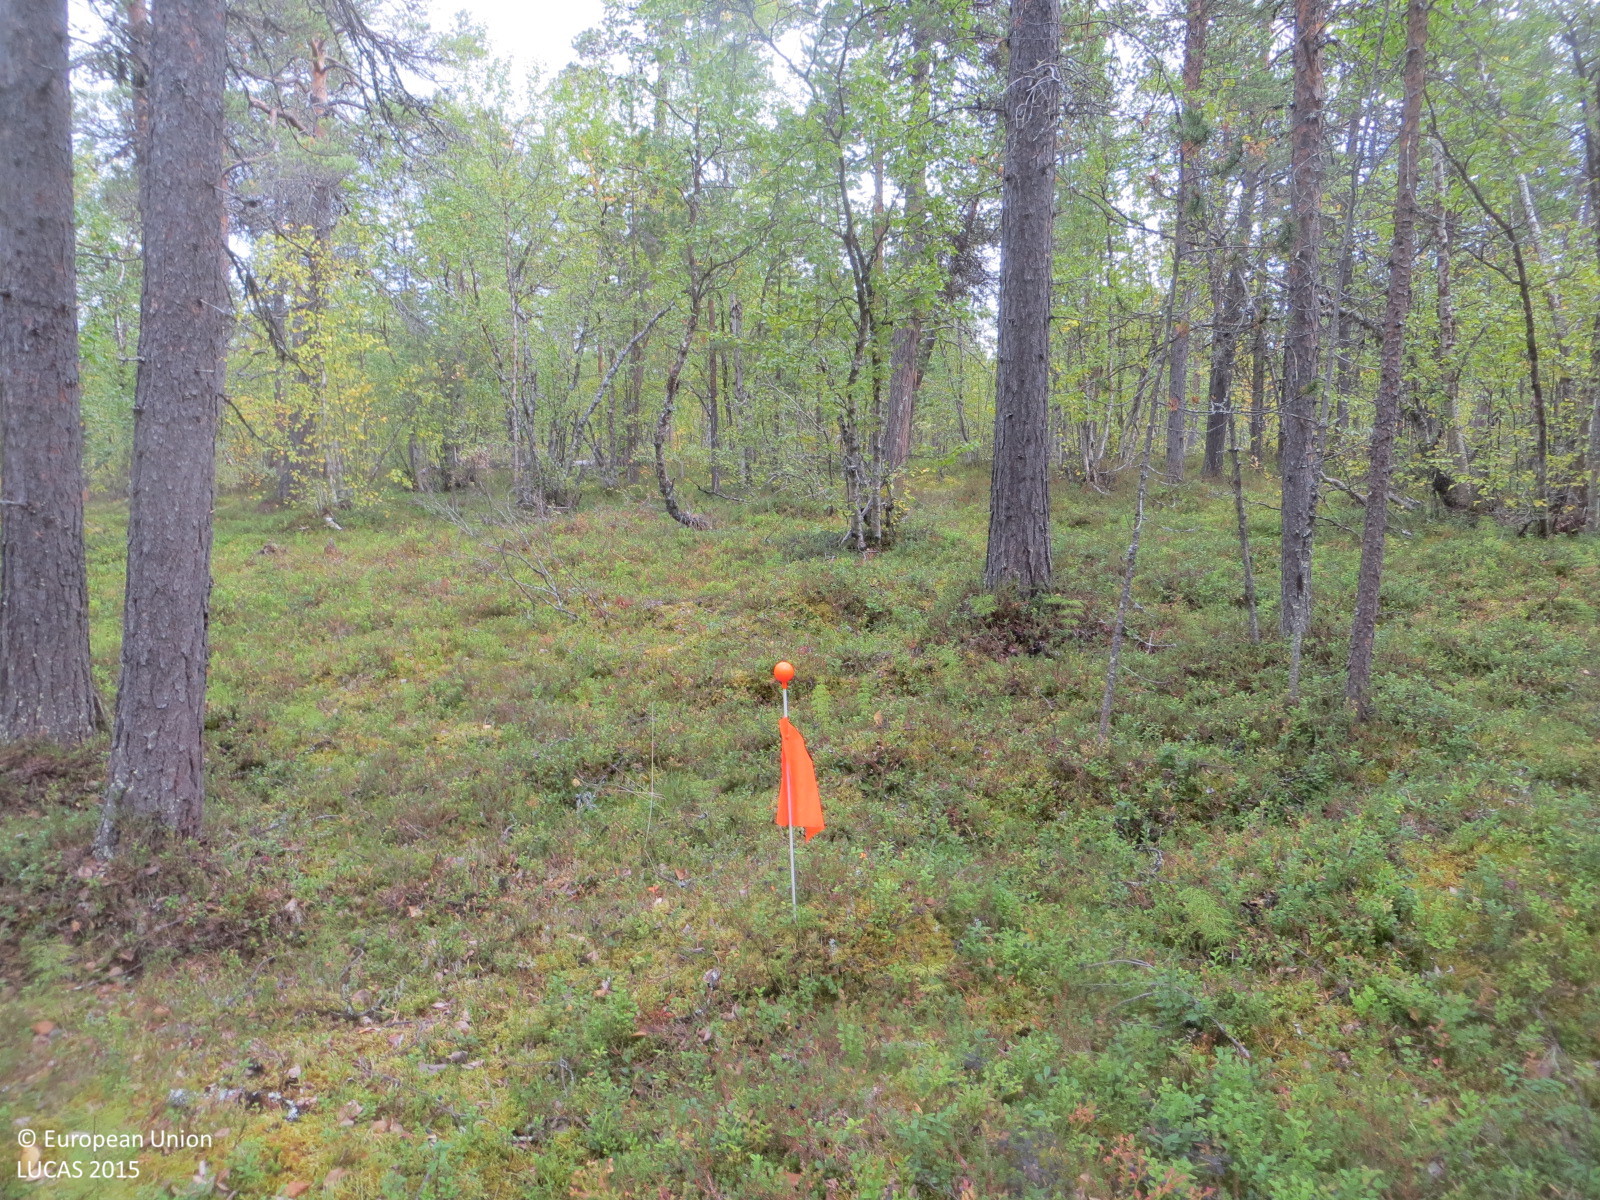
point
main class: Woodland
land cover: Pine dominated mixed woodland
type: boreal forest
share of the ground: 50 - 75 %
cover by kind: shrubs 50 %, coniferous forest trees 35 %, broadleaved forest trees 15 %
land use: Forestry
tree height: > 5 m
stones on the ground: < 10 %
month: September
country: FI
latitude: 68.3580
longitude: 24.1288
